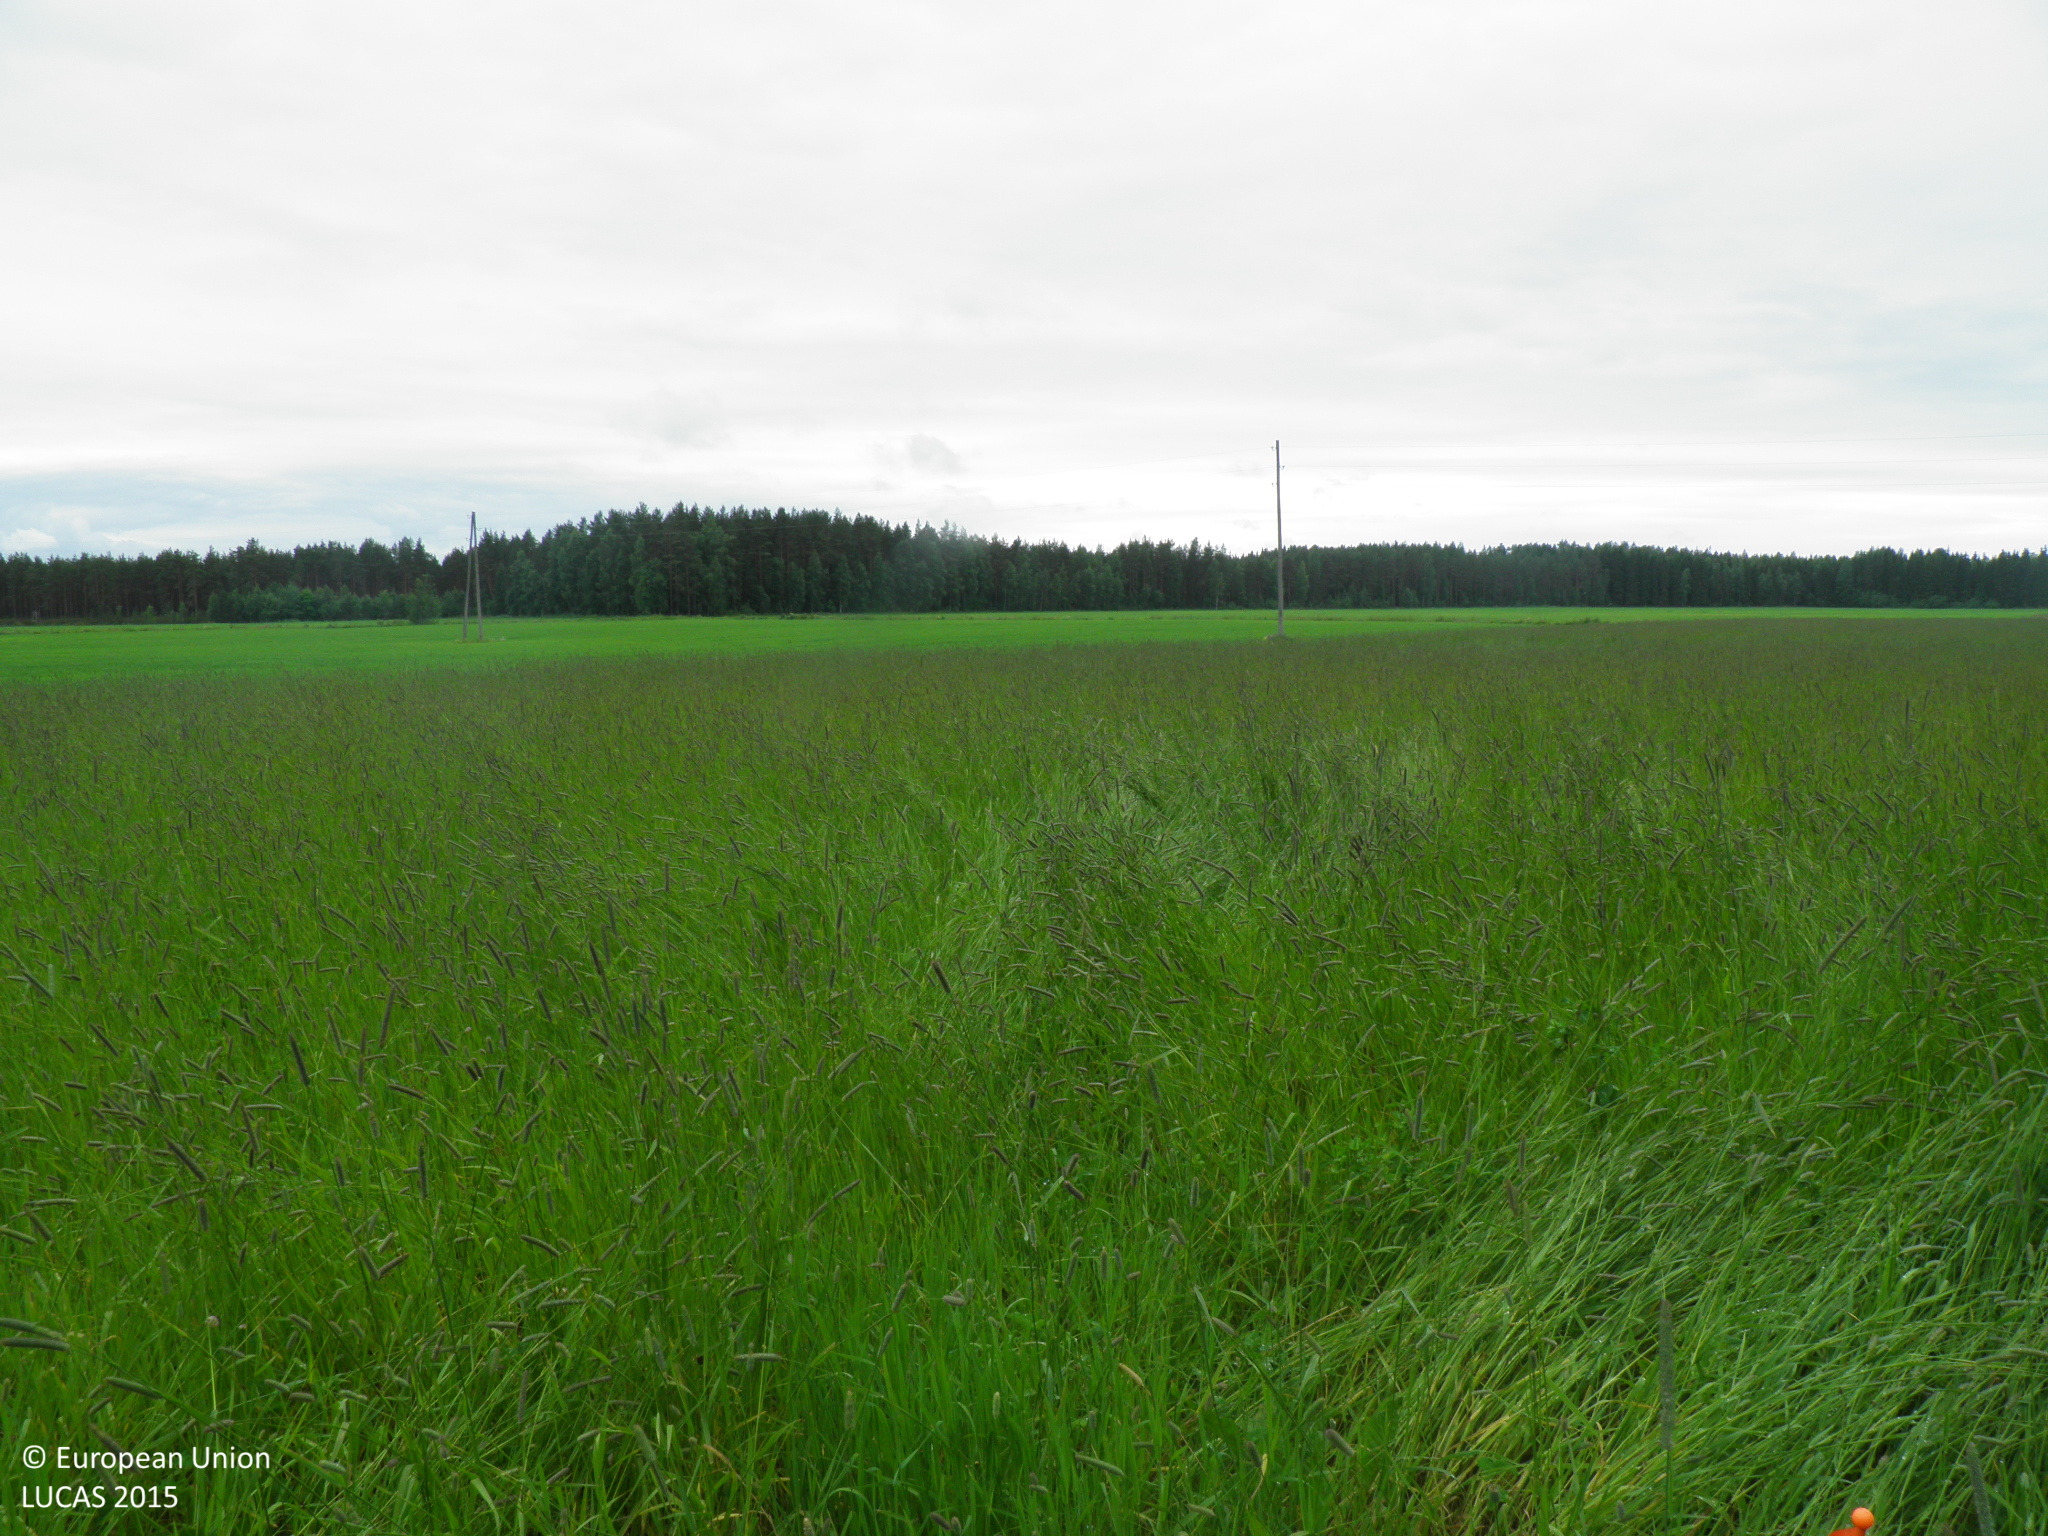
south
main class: Cropland
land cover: Temporary grasslands
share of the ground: > 75 %
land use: Agriculture (excluding fallow land and kitchen gardens)
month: July
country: FI
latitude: 60.6844
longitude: 22.8732
